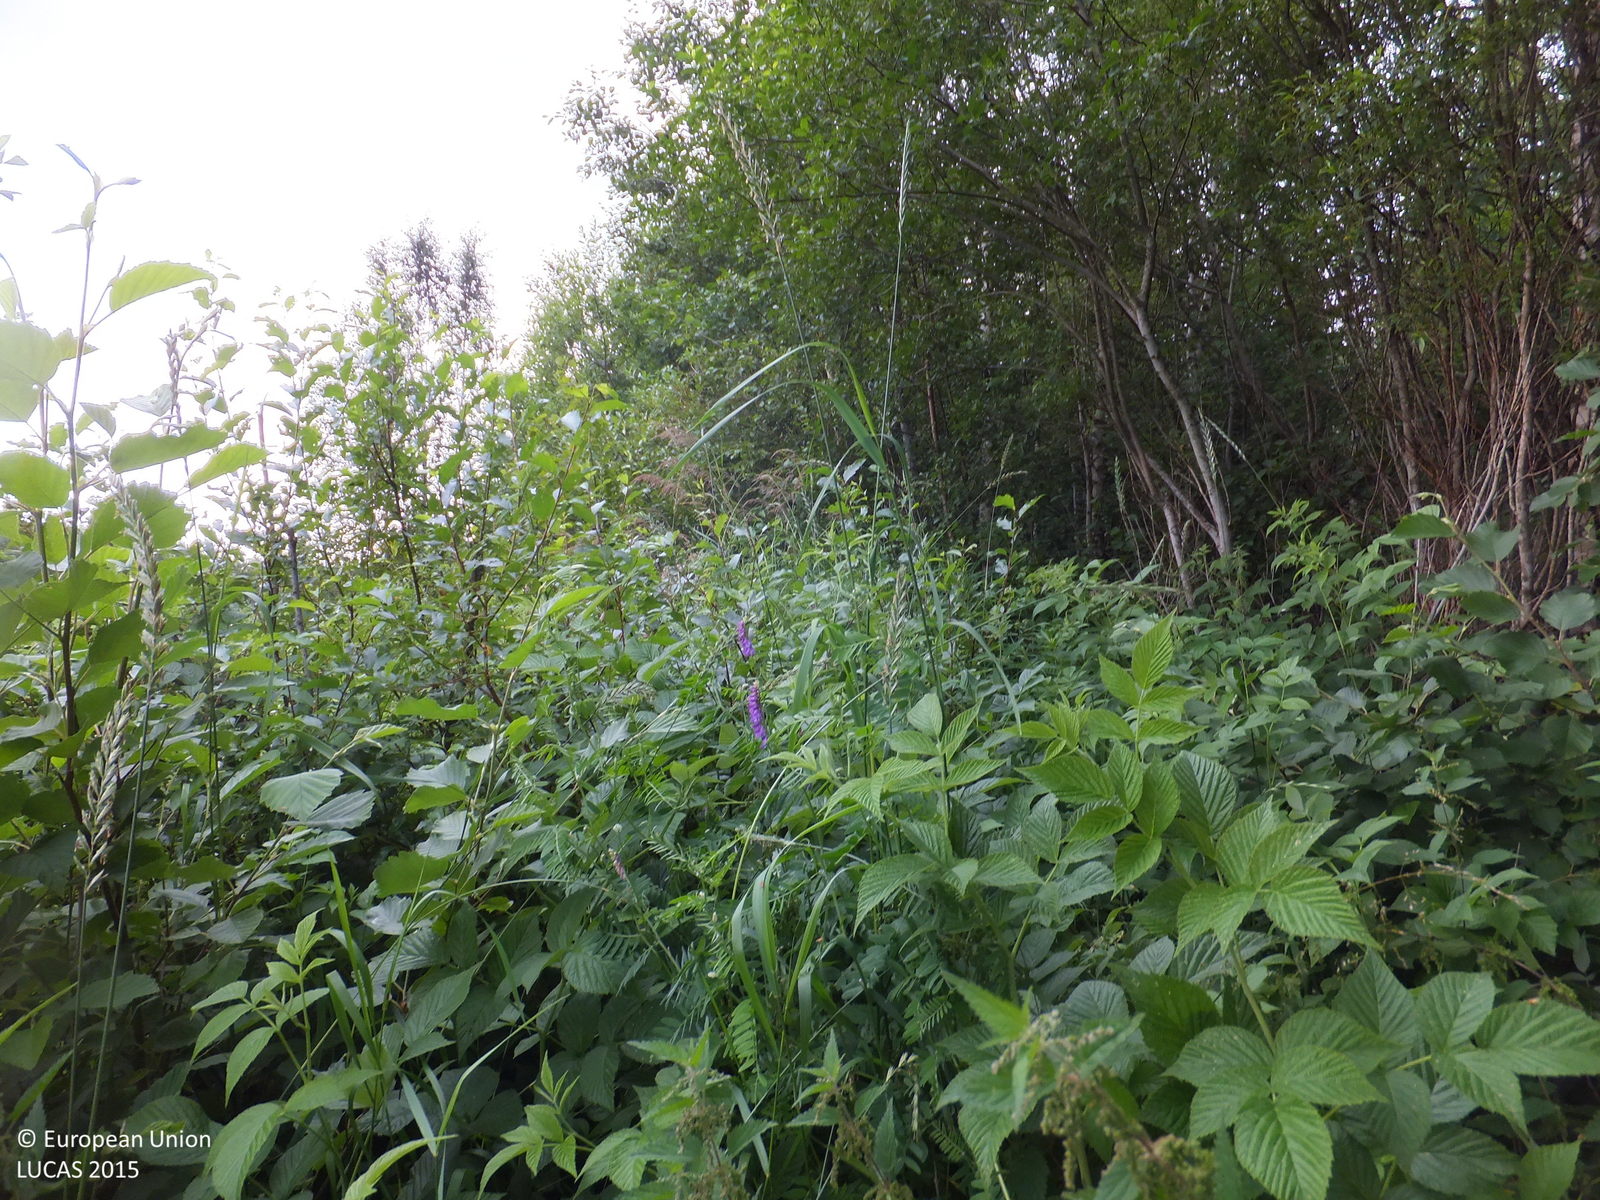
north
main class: Woodland
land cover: Broadleaved woodland
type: boreal forest
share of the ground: > 75 %
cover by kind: broadleaved forest trees 60 %, herbaceous plants 25 %, shrubs 15 %
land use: Forestry
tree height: > 5 m
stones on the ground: < 10 %
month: July
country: FI
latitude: 63.0917
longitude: 21.8669
